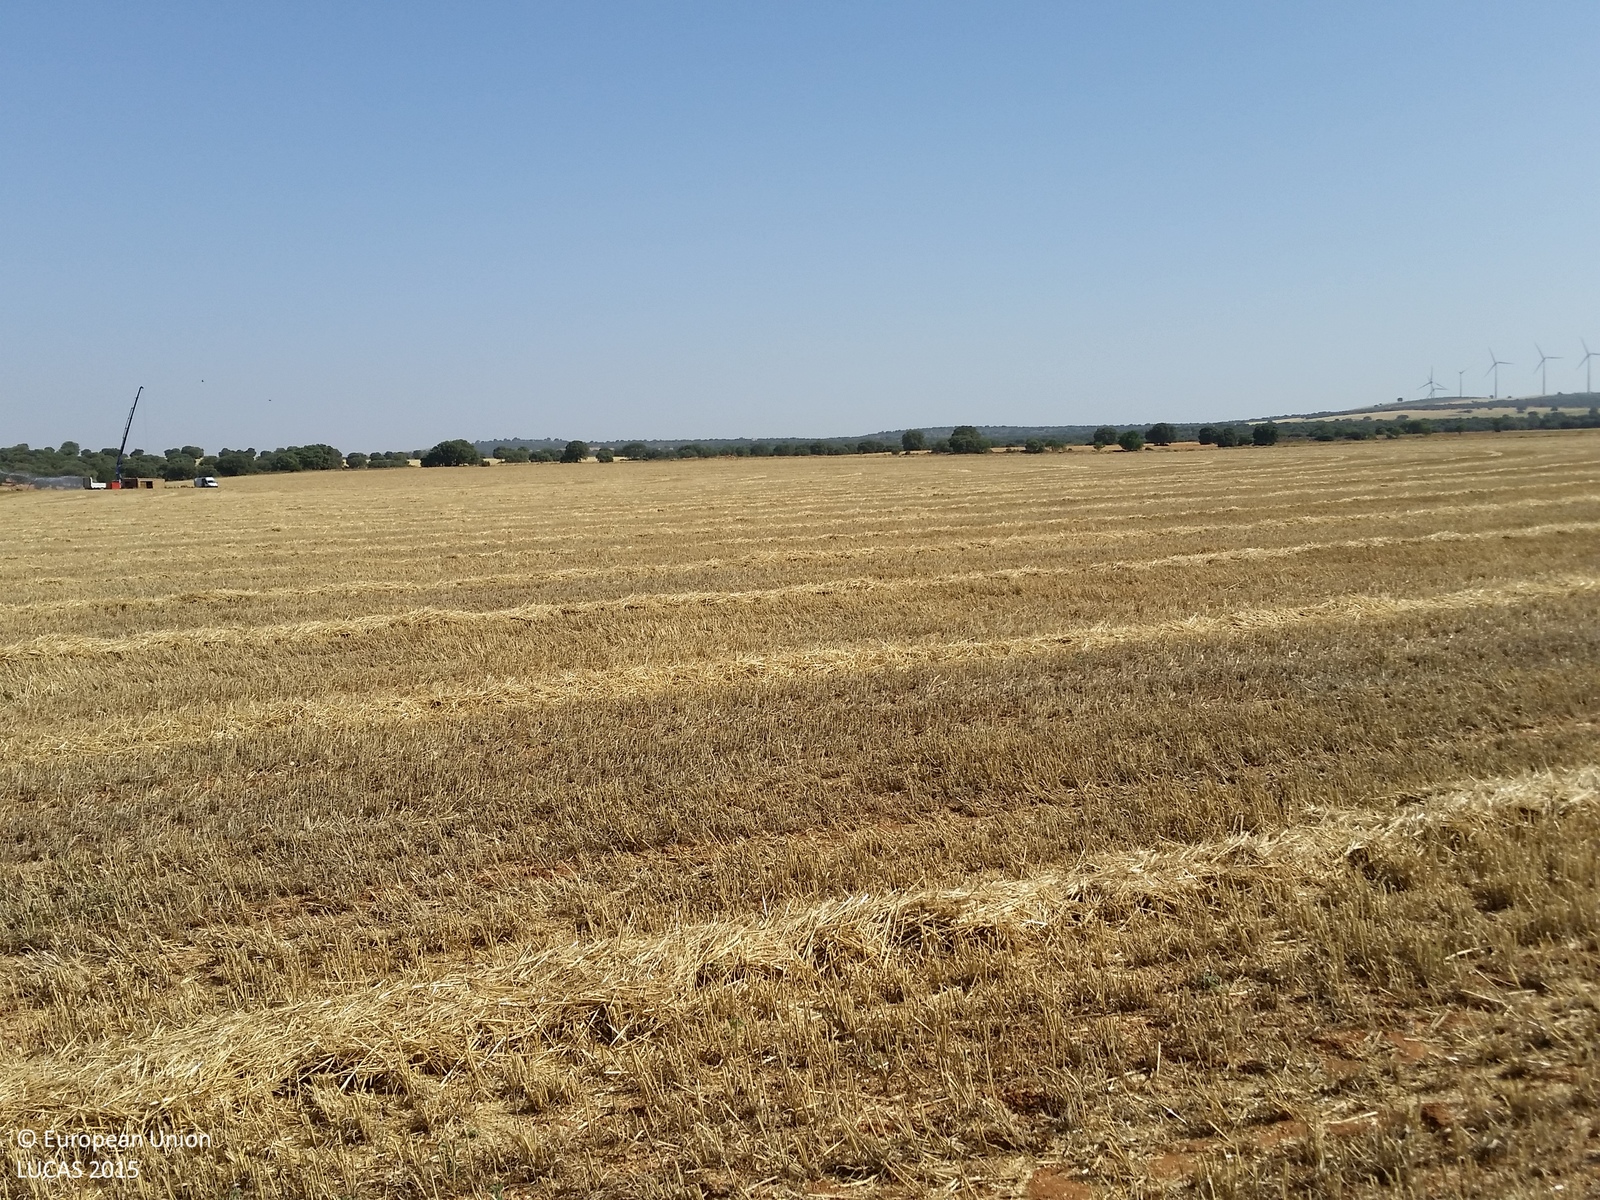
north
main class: Cropland
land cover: Common wheat
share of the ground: < 10 %
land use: Agriculture (excluding fallow land and kitchen gardens)
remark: Harvested field
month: July
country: ES
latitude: 38.9460
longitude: -2.6868
